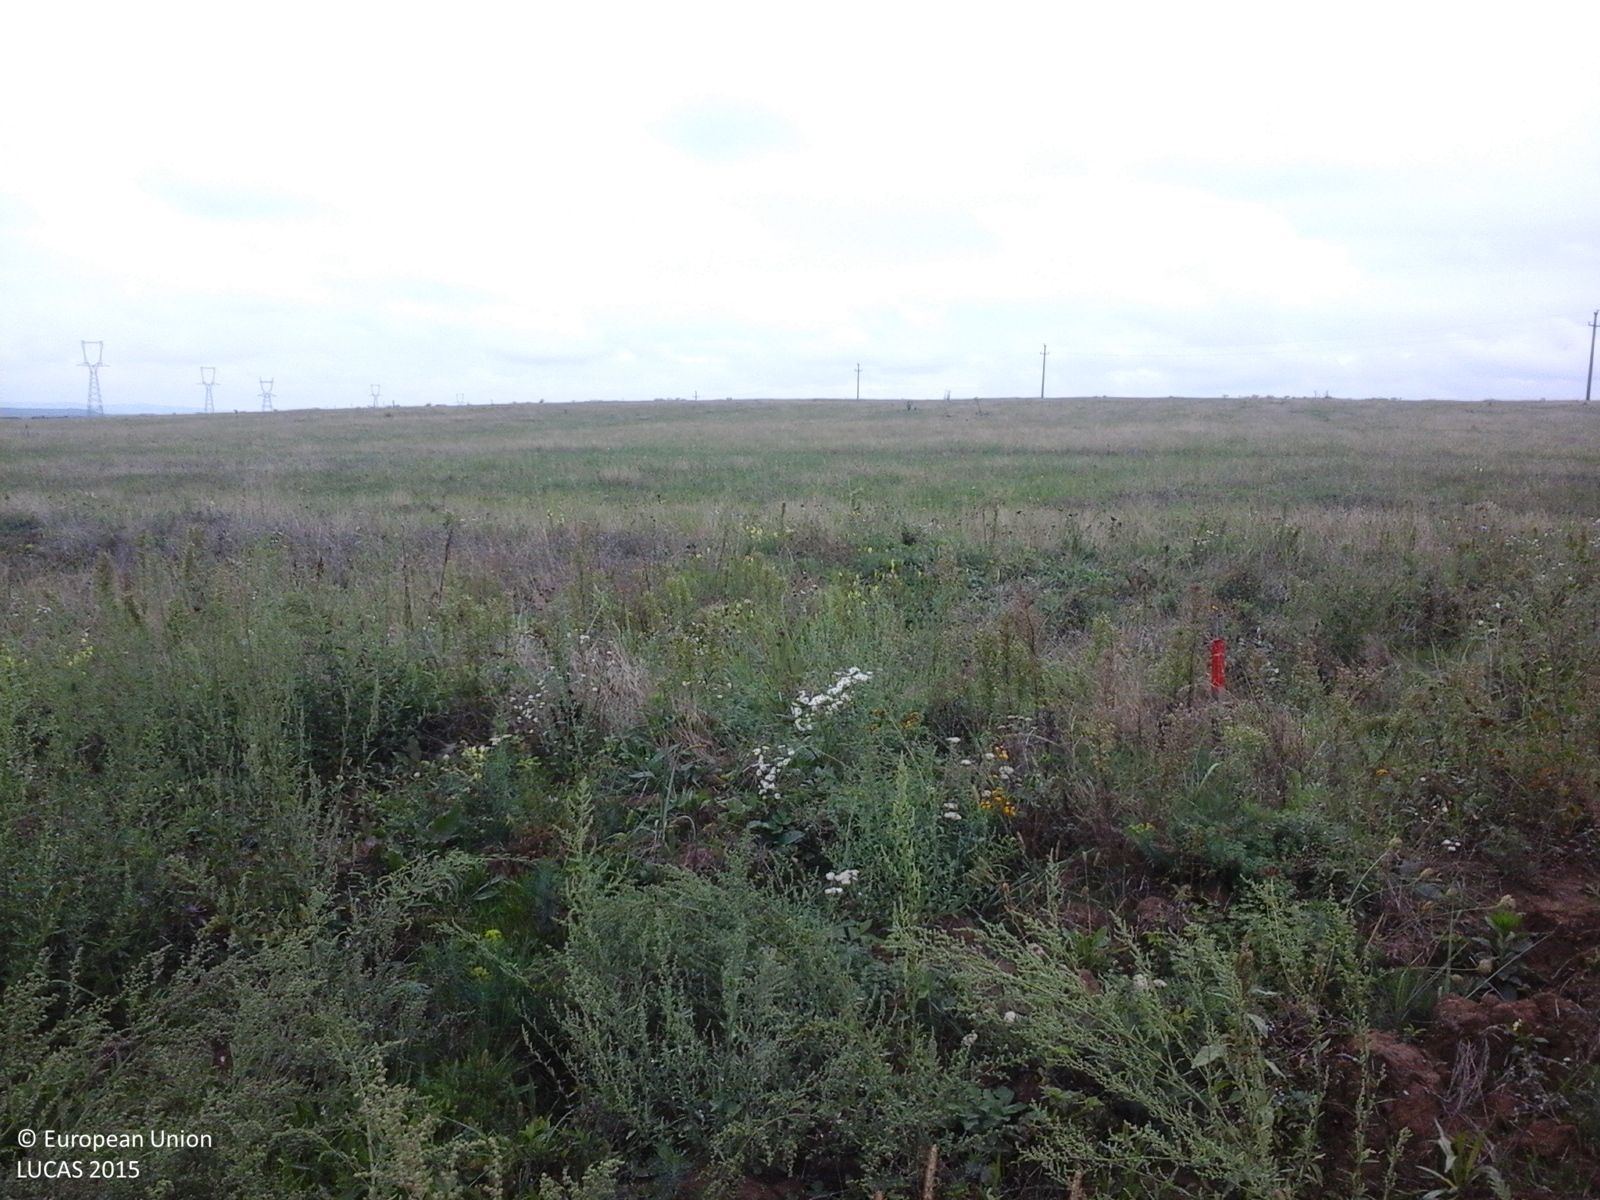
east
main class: Cropland
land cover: Sunflower
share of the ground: > 75 %
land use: Agriculture (excluding fallow land and kitchen gardens)
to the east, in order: Sunflower; Abandoned hedges; Grassland without tree/shrub cover; Electric lines; Grassland without tree/shrub cover
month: September
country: RO
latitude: 46.9624
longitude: 21.8595
